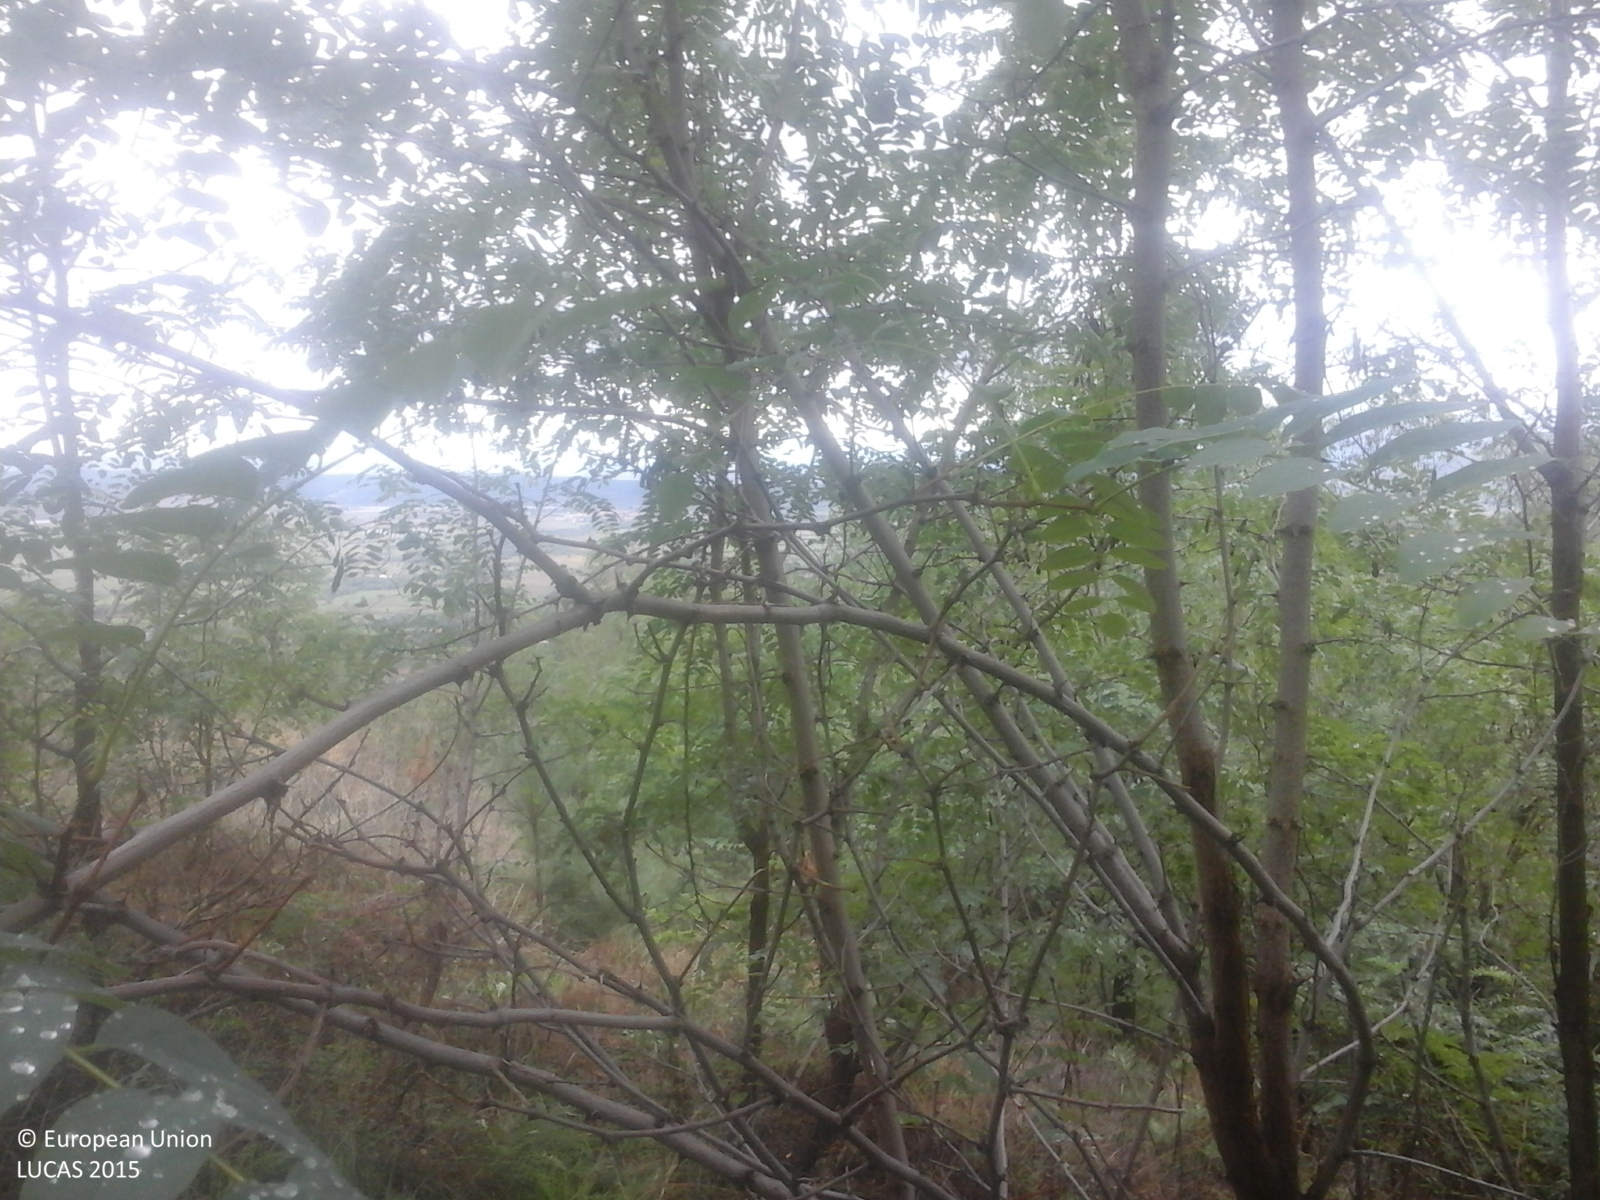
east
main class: Woodland
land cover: Broadleaved woodland
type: exotic forest
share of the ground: > 75 %
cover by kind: broadleaved forest trees 100 %
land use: Forestry
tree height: > 5 m
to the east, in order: Broadleaved woodland; Tracks; Broadleaved woodland; Tracks; Abandoned hedges; Grassland with sparse tree/shrub cover; Shrubland without tree cover; Grassland with sparse tree/shrub cover; Broadleaved woodland; Shrubland without tree cover
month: September
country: RO
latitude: 45.7890
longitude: 23.8723
